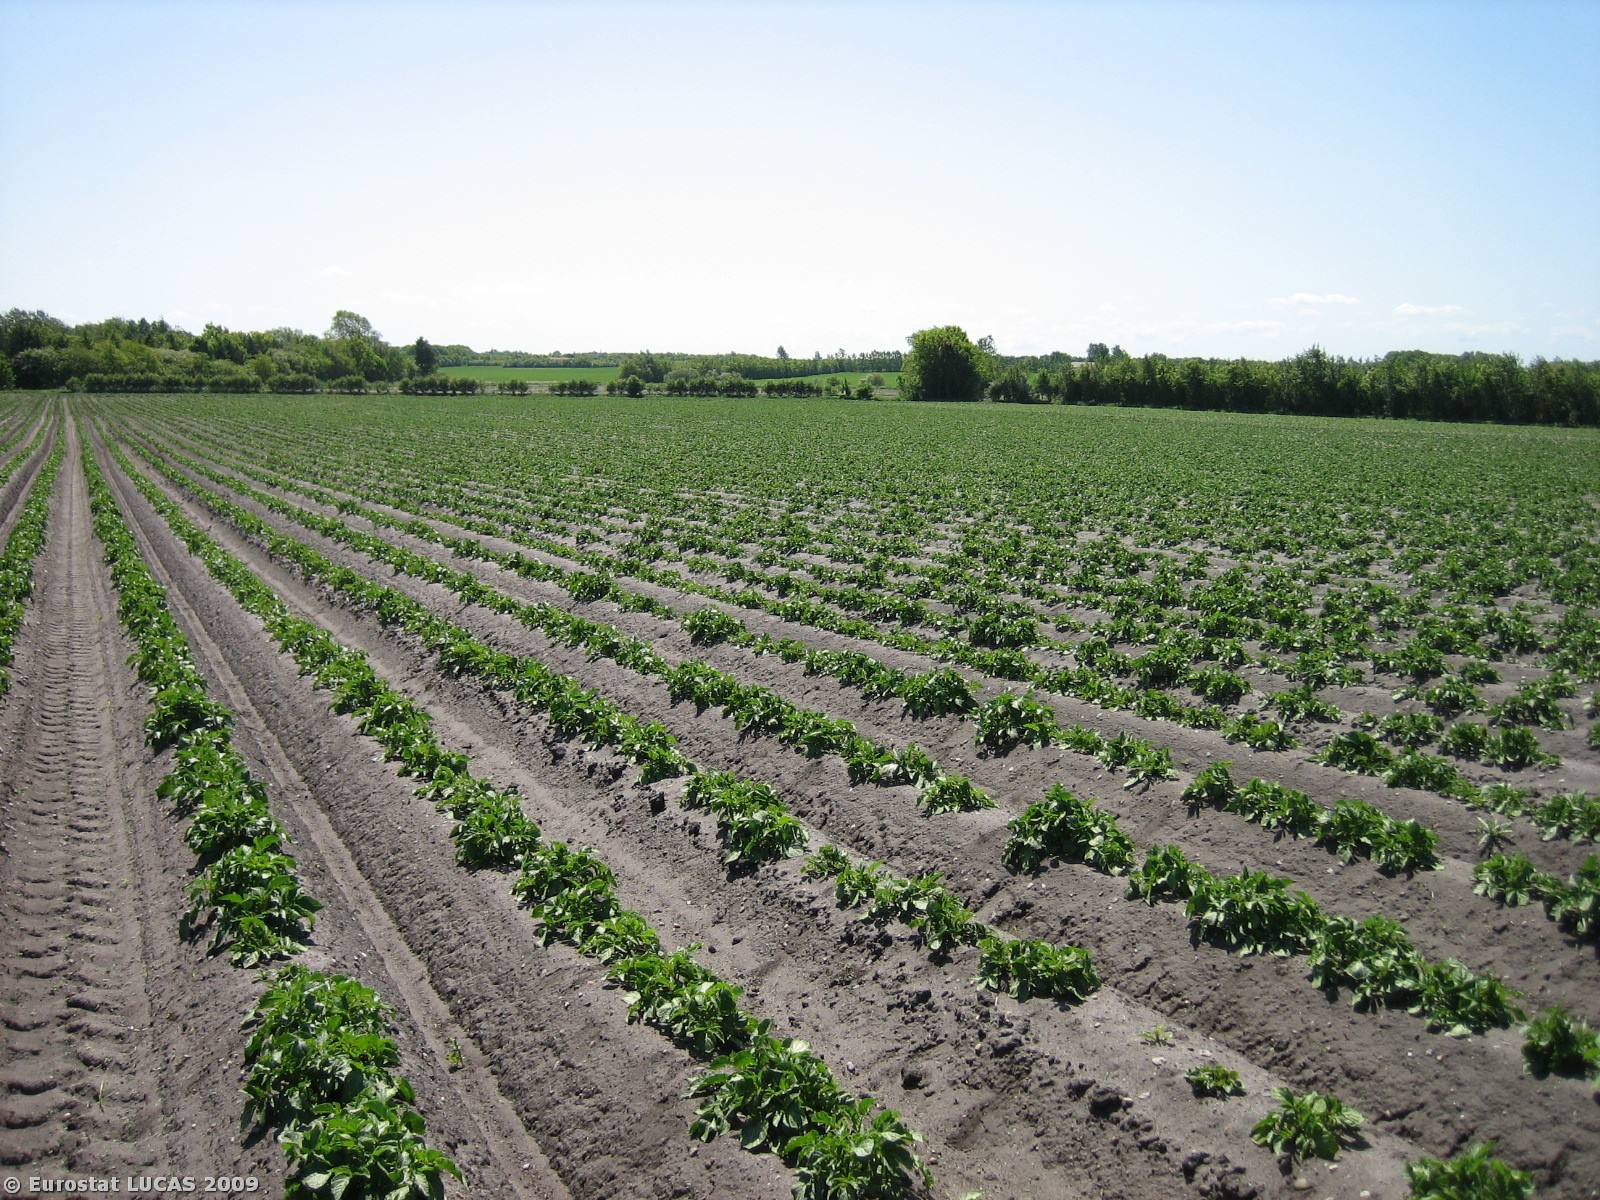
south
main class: Cropland
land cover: Potatoes
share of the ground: 10 - 25 %
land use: Agriculture (excluding fallow land and kitchen gardens)
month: May
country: DK
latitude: 55.9128
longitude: 8.8333
